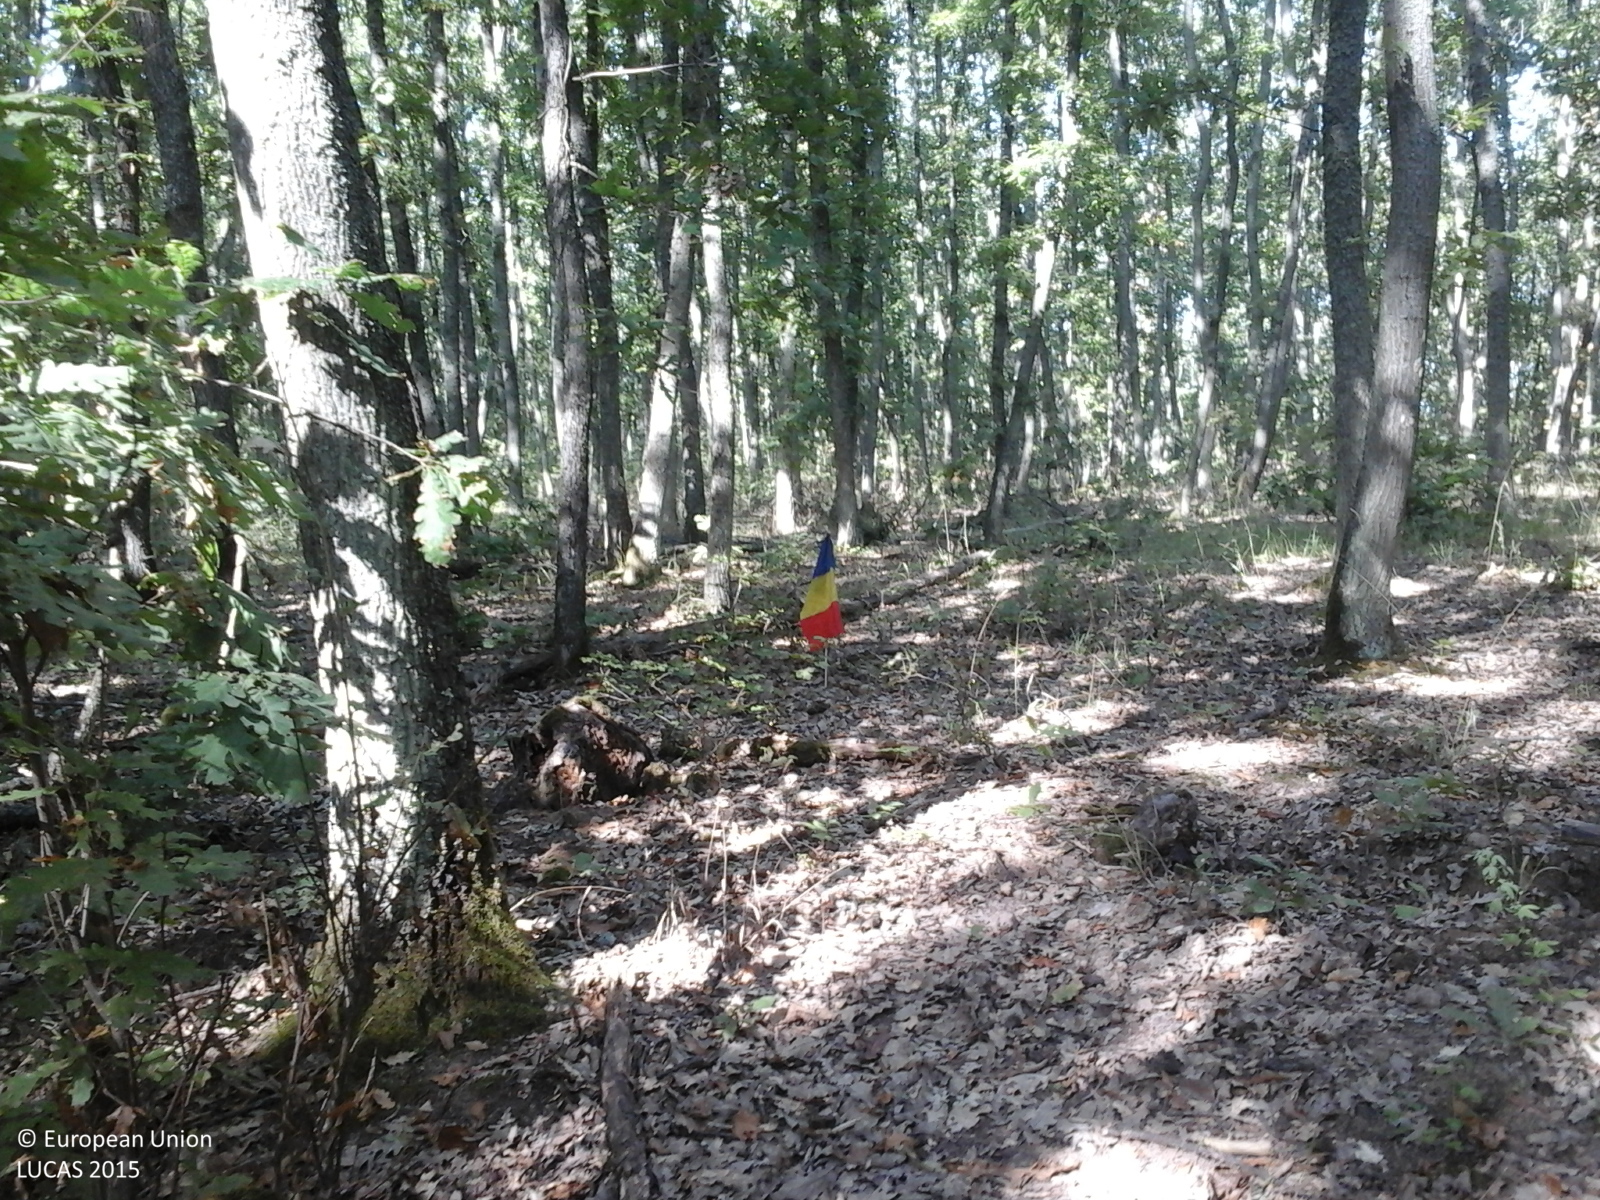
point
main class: Woodland
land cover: Broadleaved woodland
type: acidophilous oak and oak-birch forest
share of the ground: > 75 %
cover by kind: broadleaved forest trees 100 %
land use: Forestry
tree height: > 5 m
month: August
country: RO
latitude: 45.9654
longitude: 21.6638
